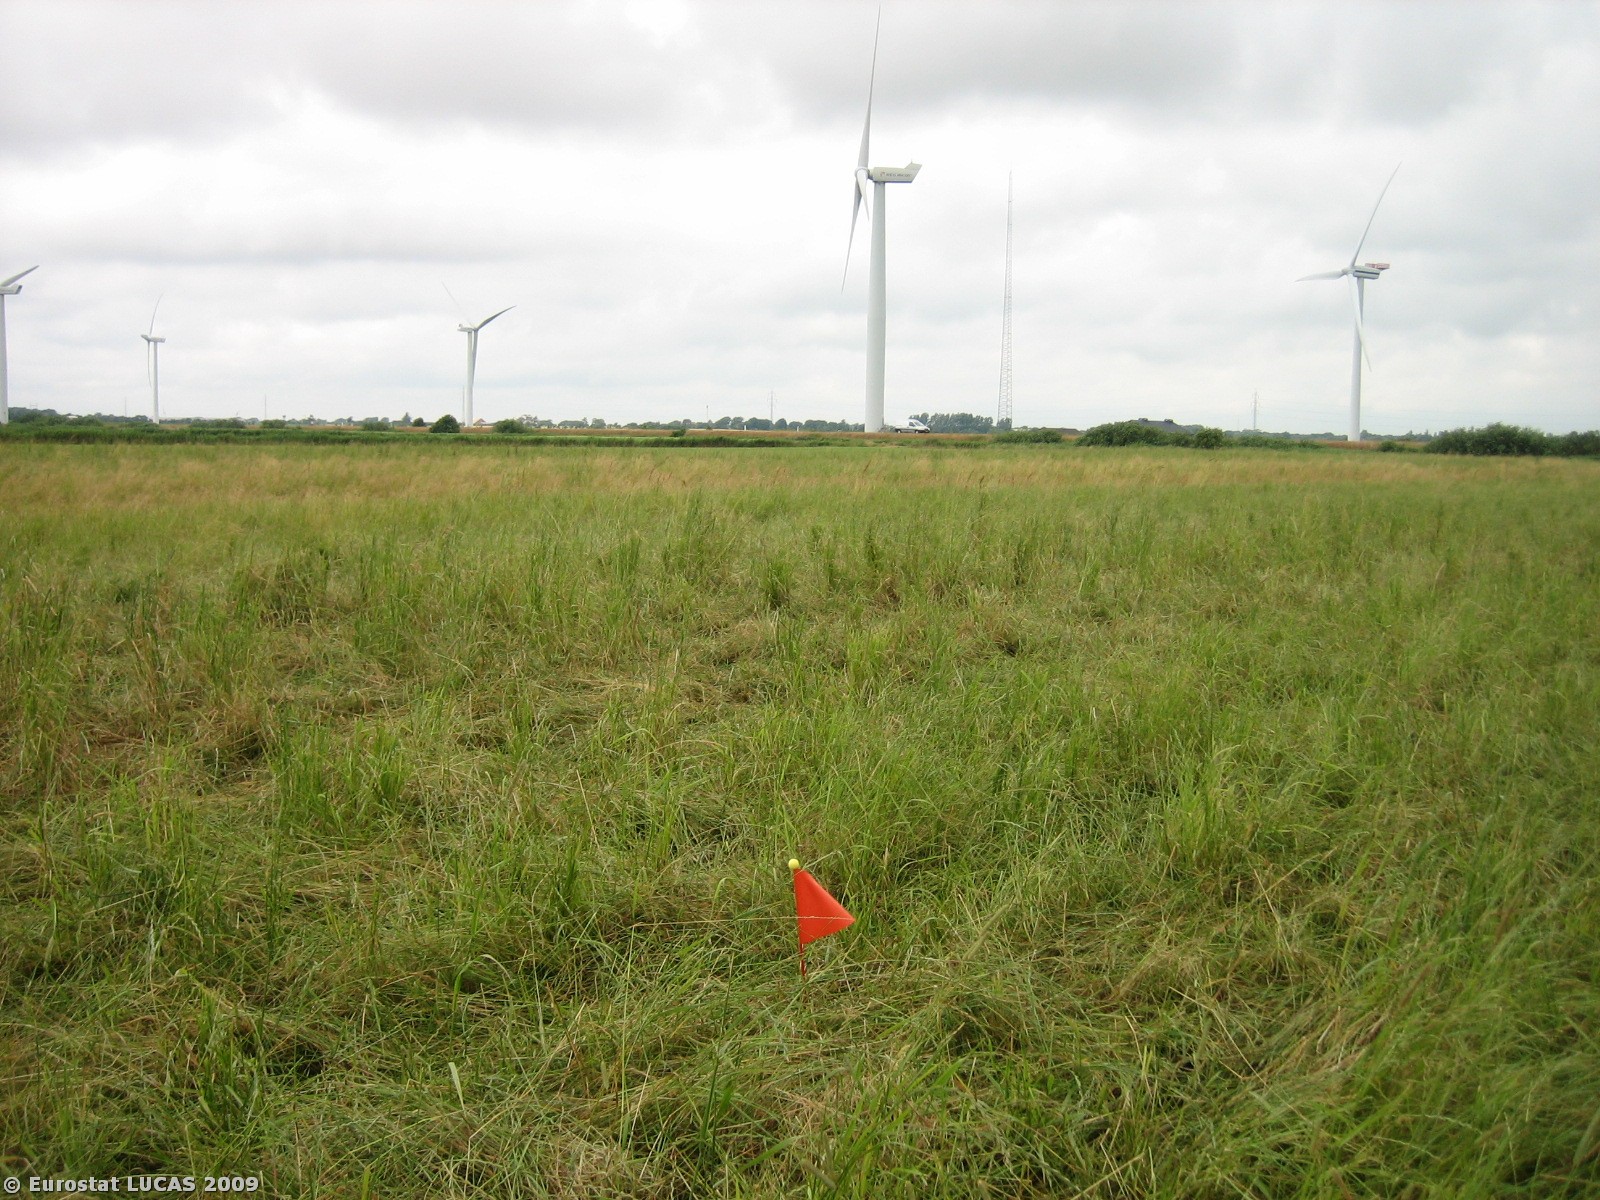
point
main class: Grassland
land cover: Grassland without tree/shrub cover
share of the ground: > 75 %
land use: Agriculture (excluding fallow land and kitchen gardens)
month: July
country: DK
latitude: 55.4430
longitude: 8.5943
